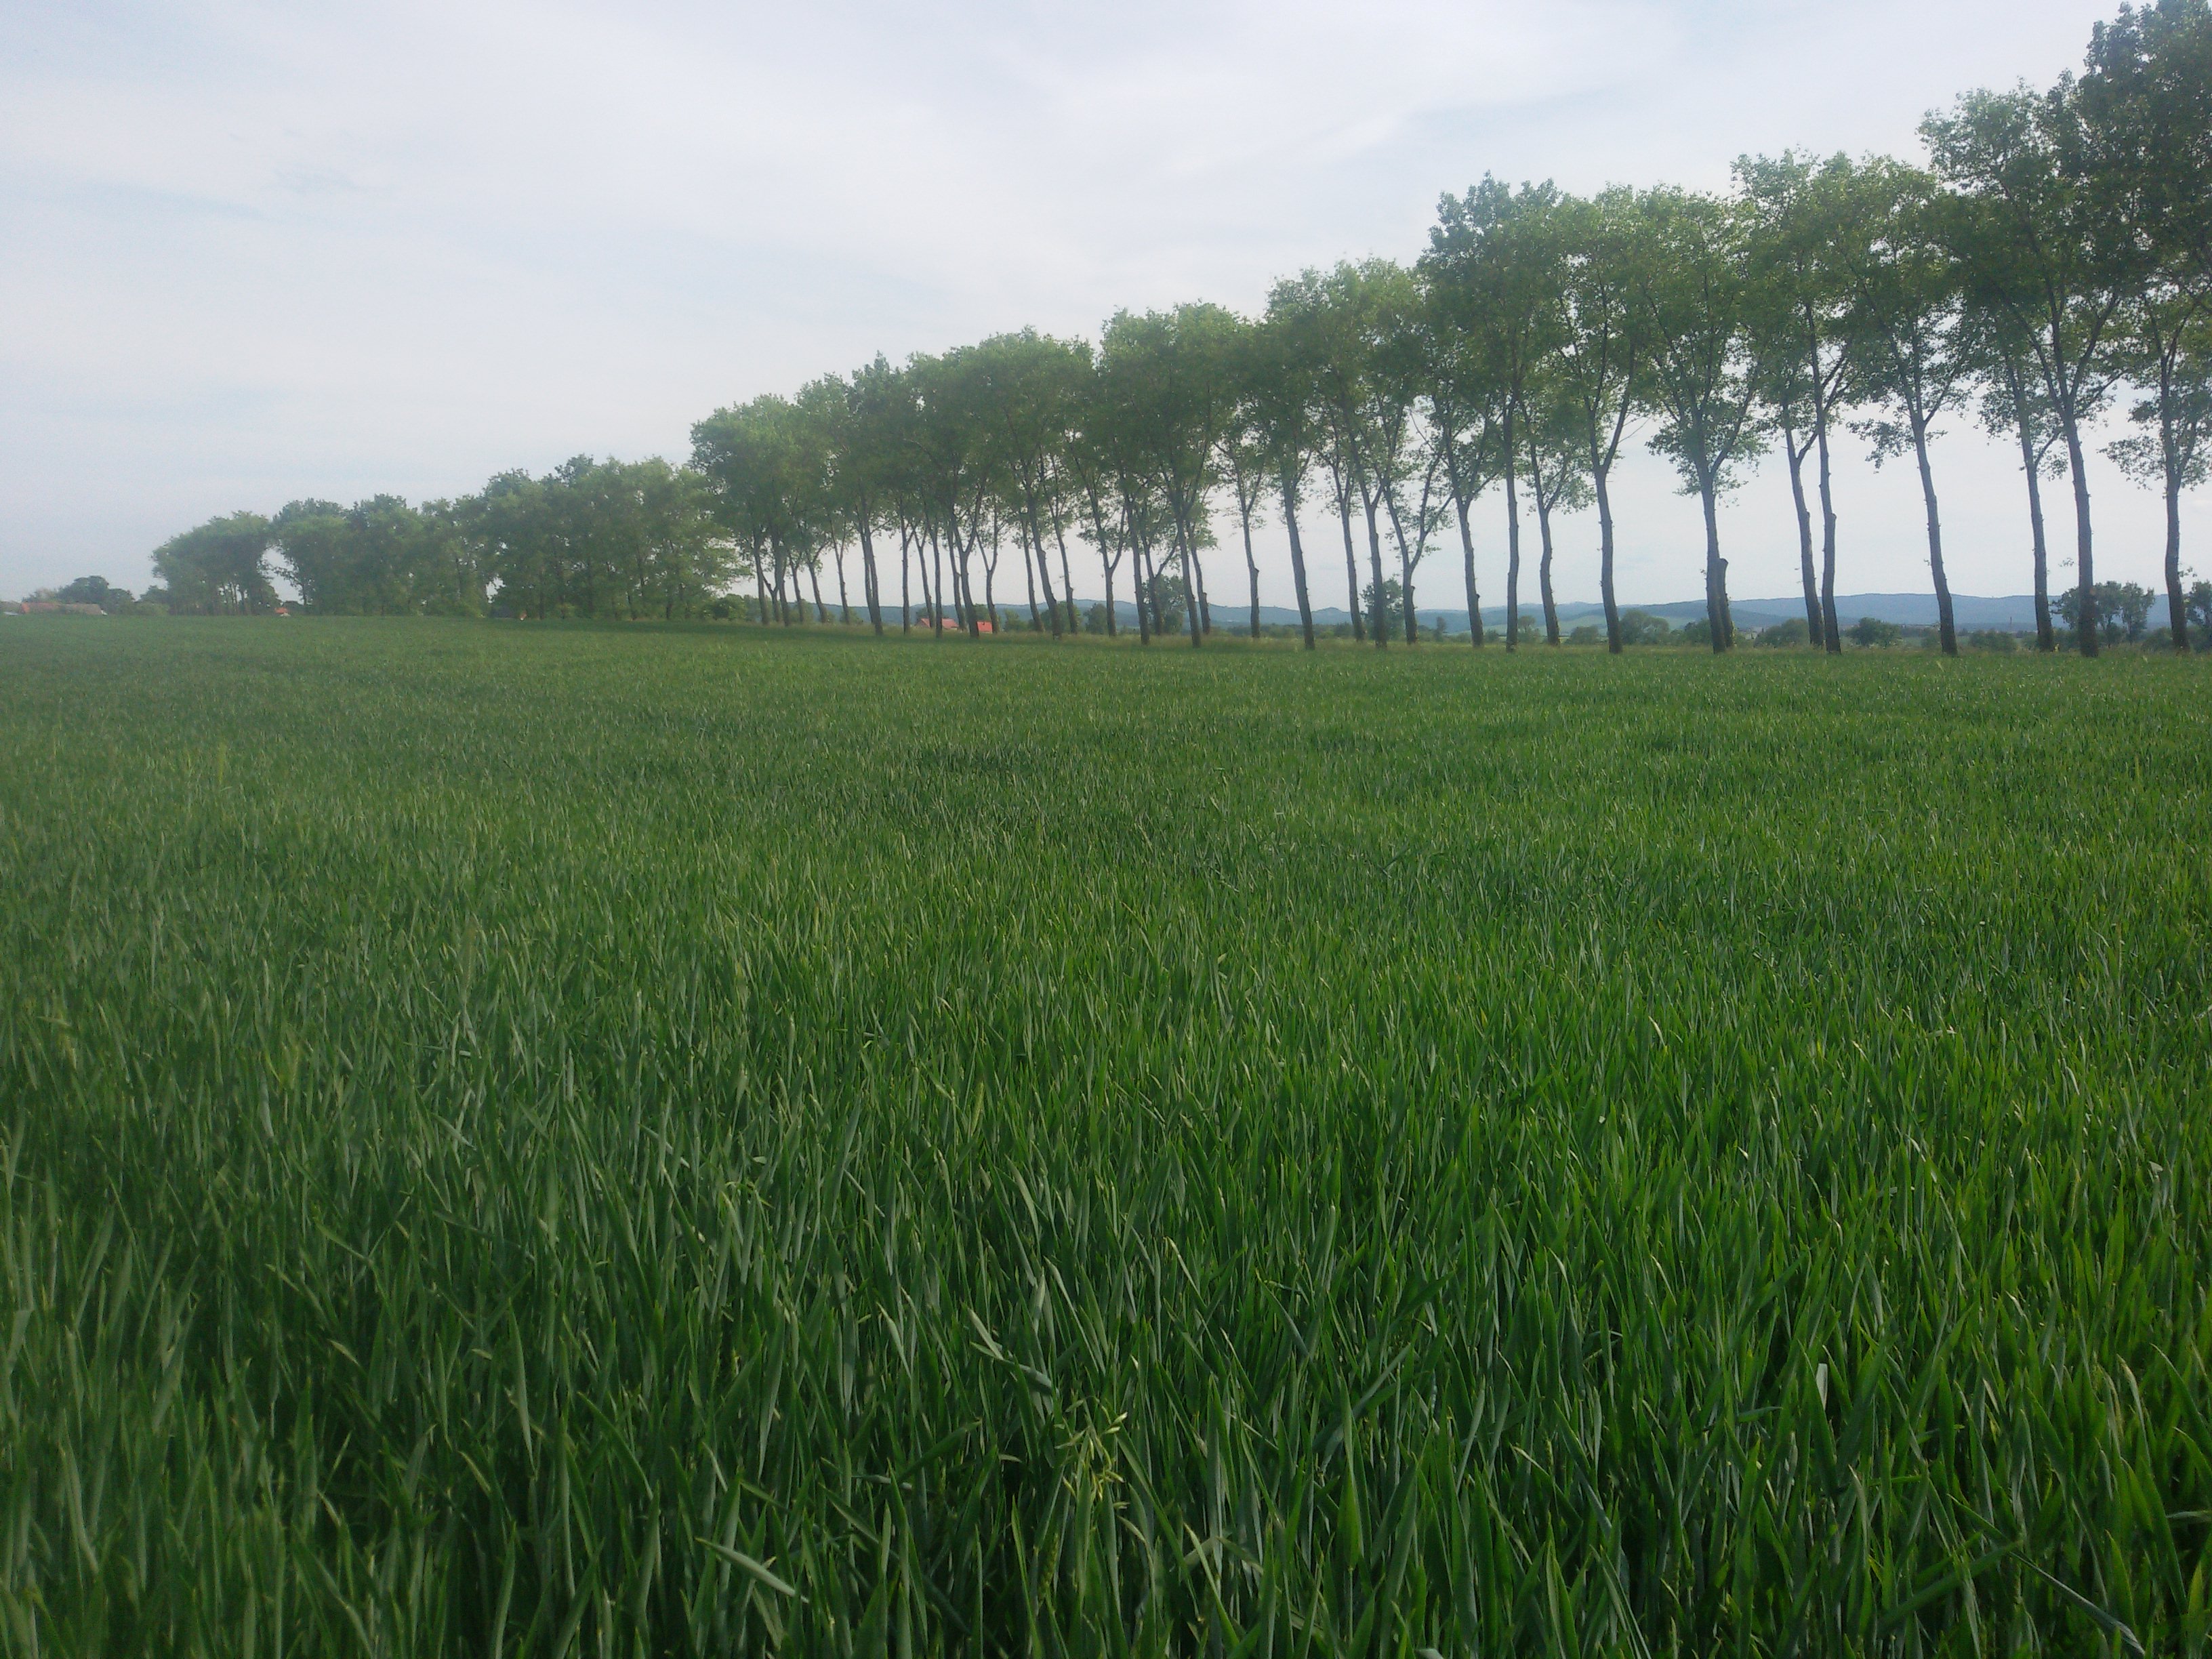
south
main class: Cropland
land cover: Rape and turnip rape
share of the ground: > 75 %
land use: Agriculture (excluding fallow land and kitchen gardens)
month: May
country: PL
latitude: 50.3448
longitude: 17.6155
